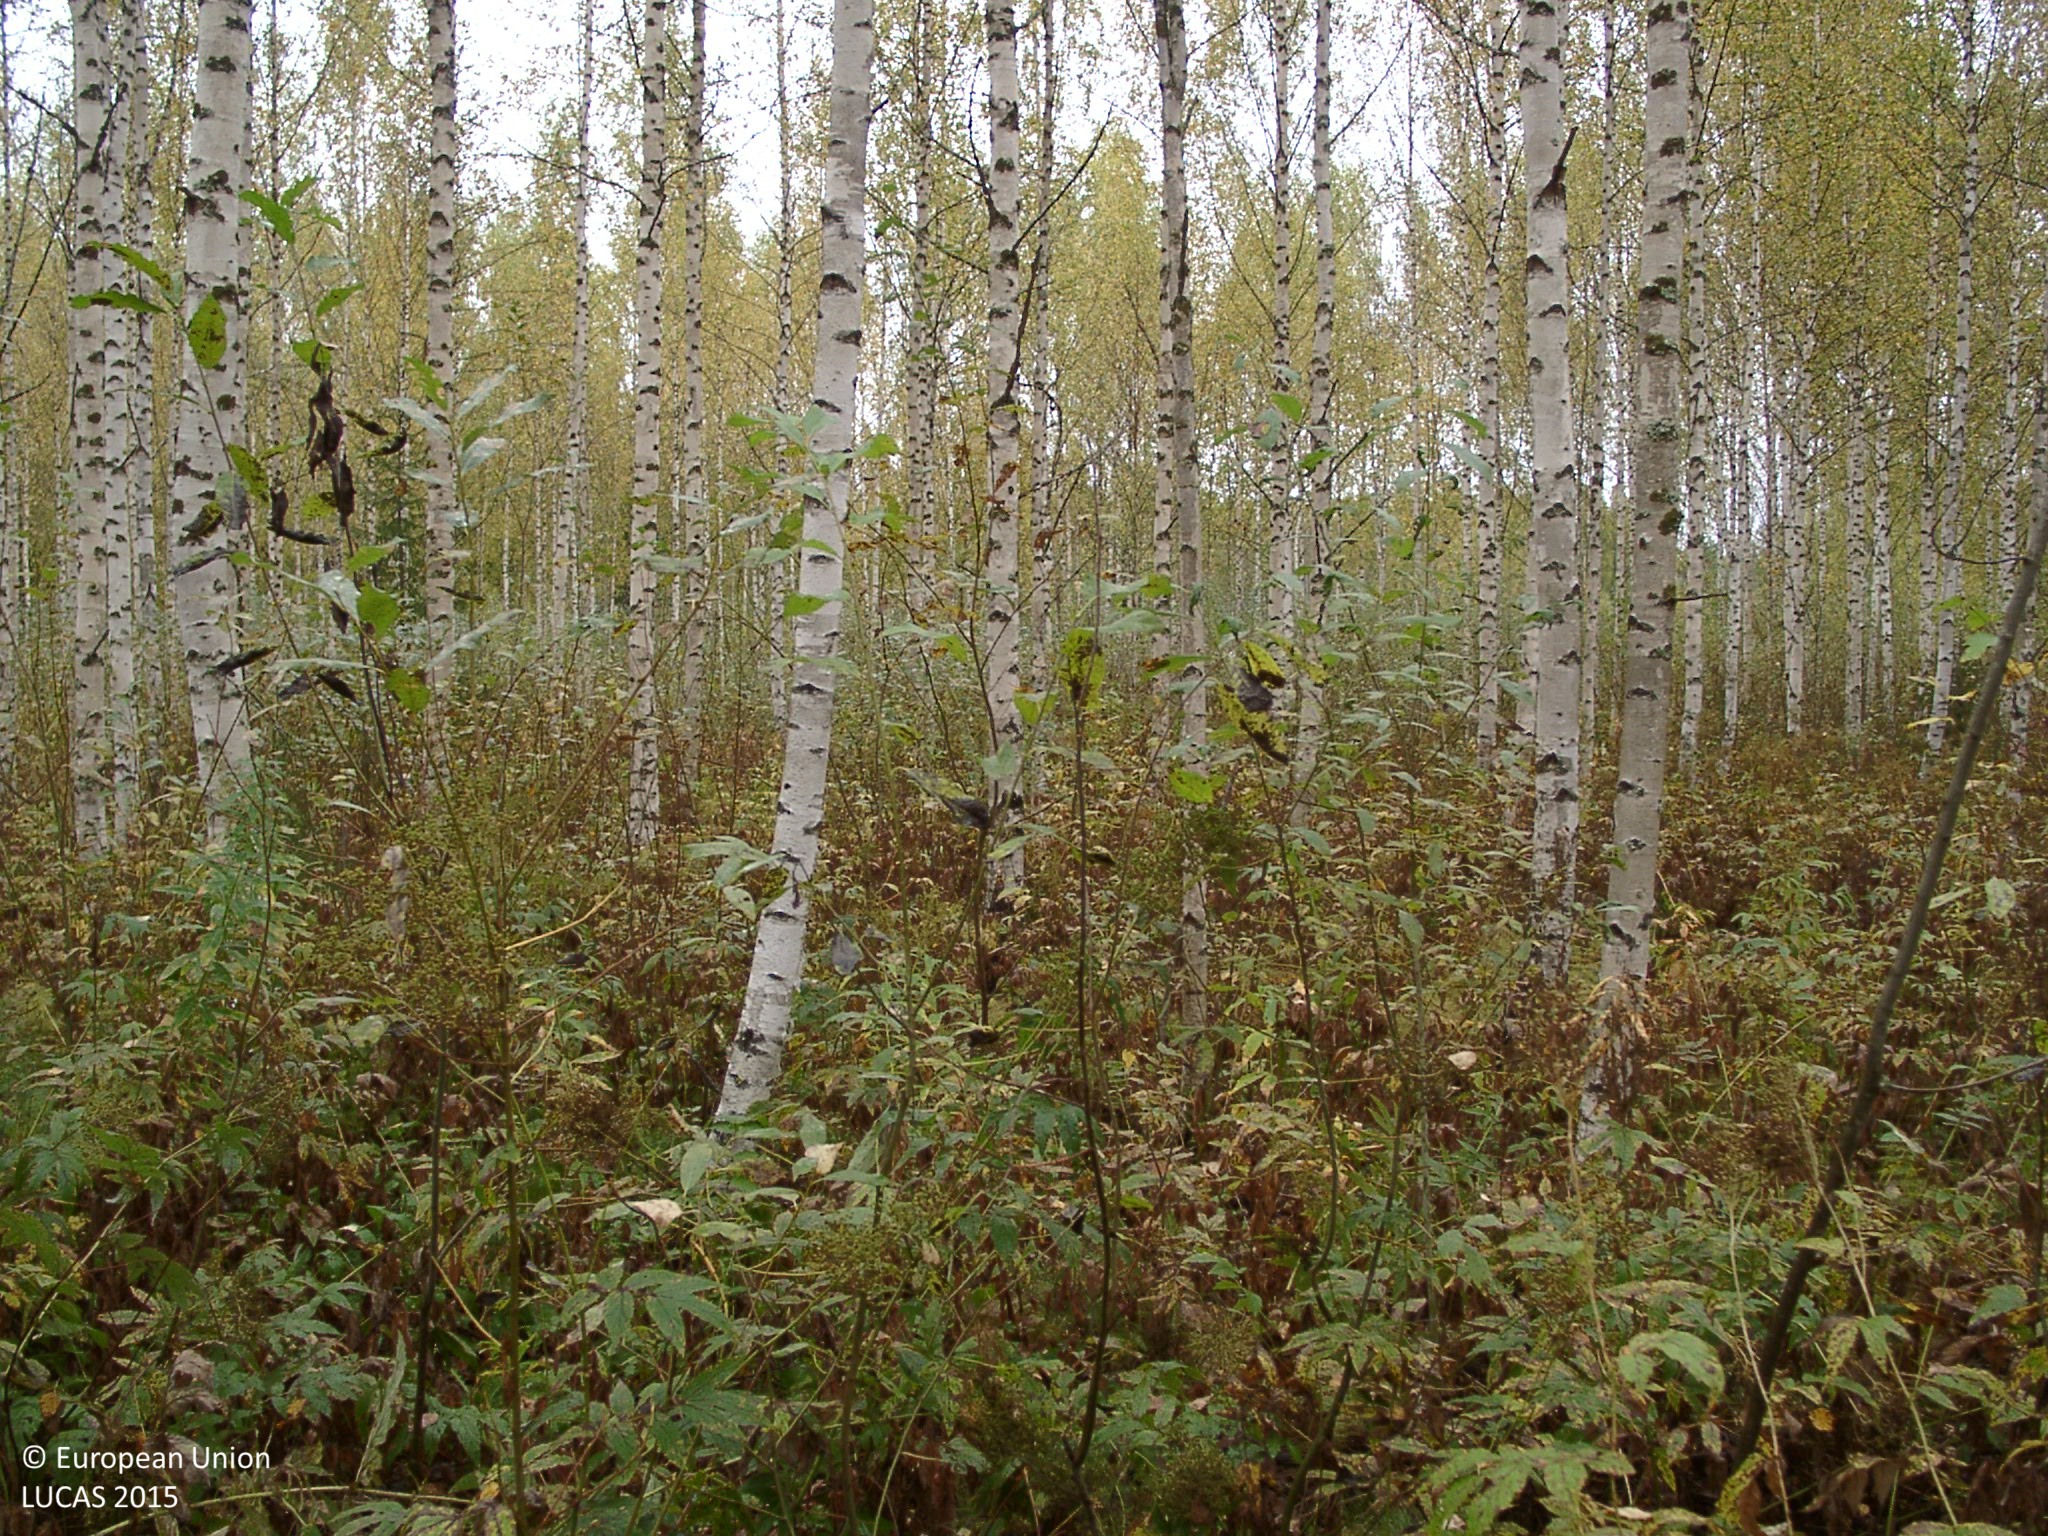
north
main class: Woodland
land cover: Broadleaved woodland
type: non-riverine alder, birch or aspen forest
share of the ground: 50 - 75 %
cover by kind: broadleaved forest trees 65 %, herbaceous plants 30 %, shrubs 5 %
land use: Forestry
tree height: > 5 m
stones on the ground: < 10 %
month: September
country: FI
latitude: 62.7577
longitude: 25.3600
